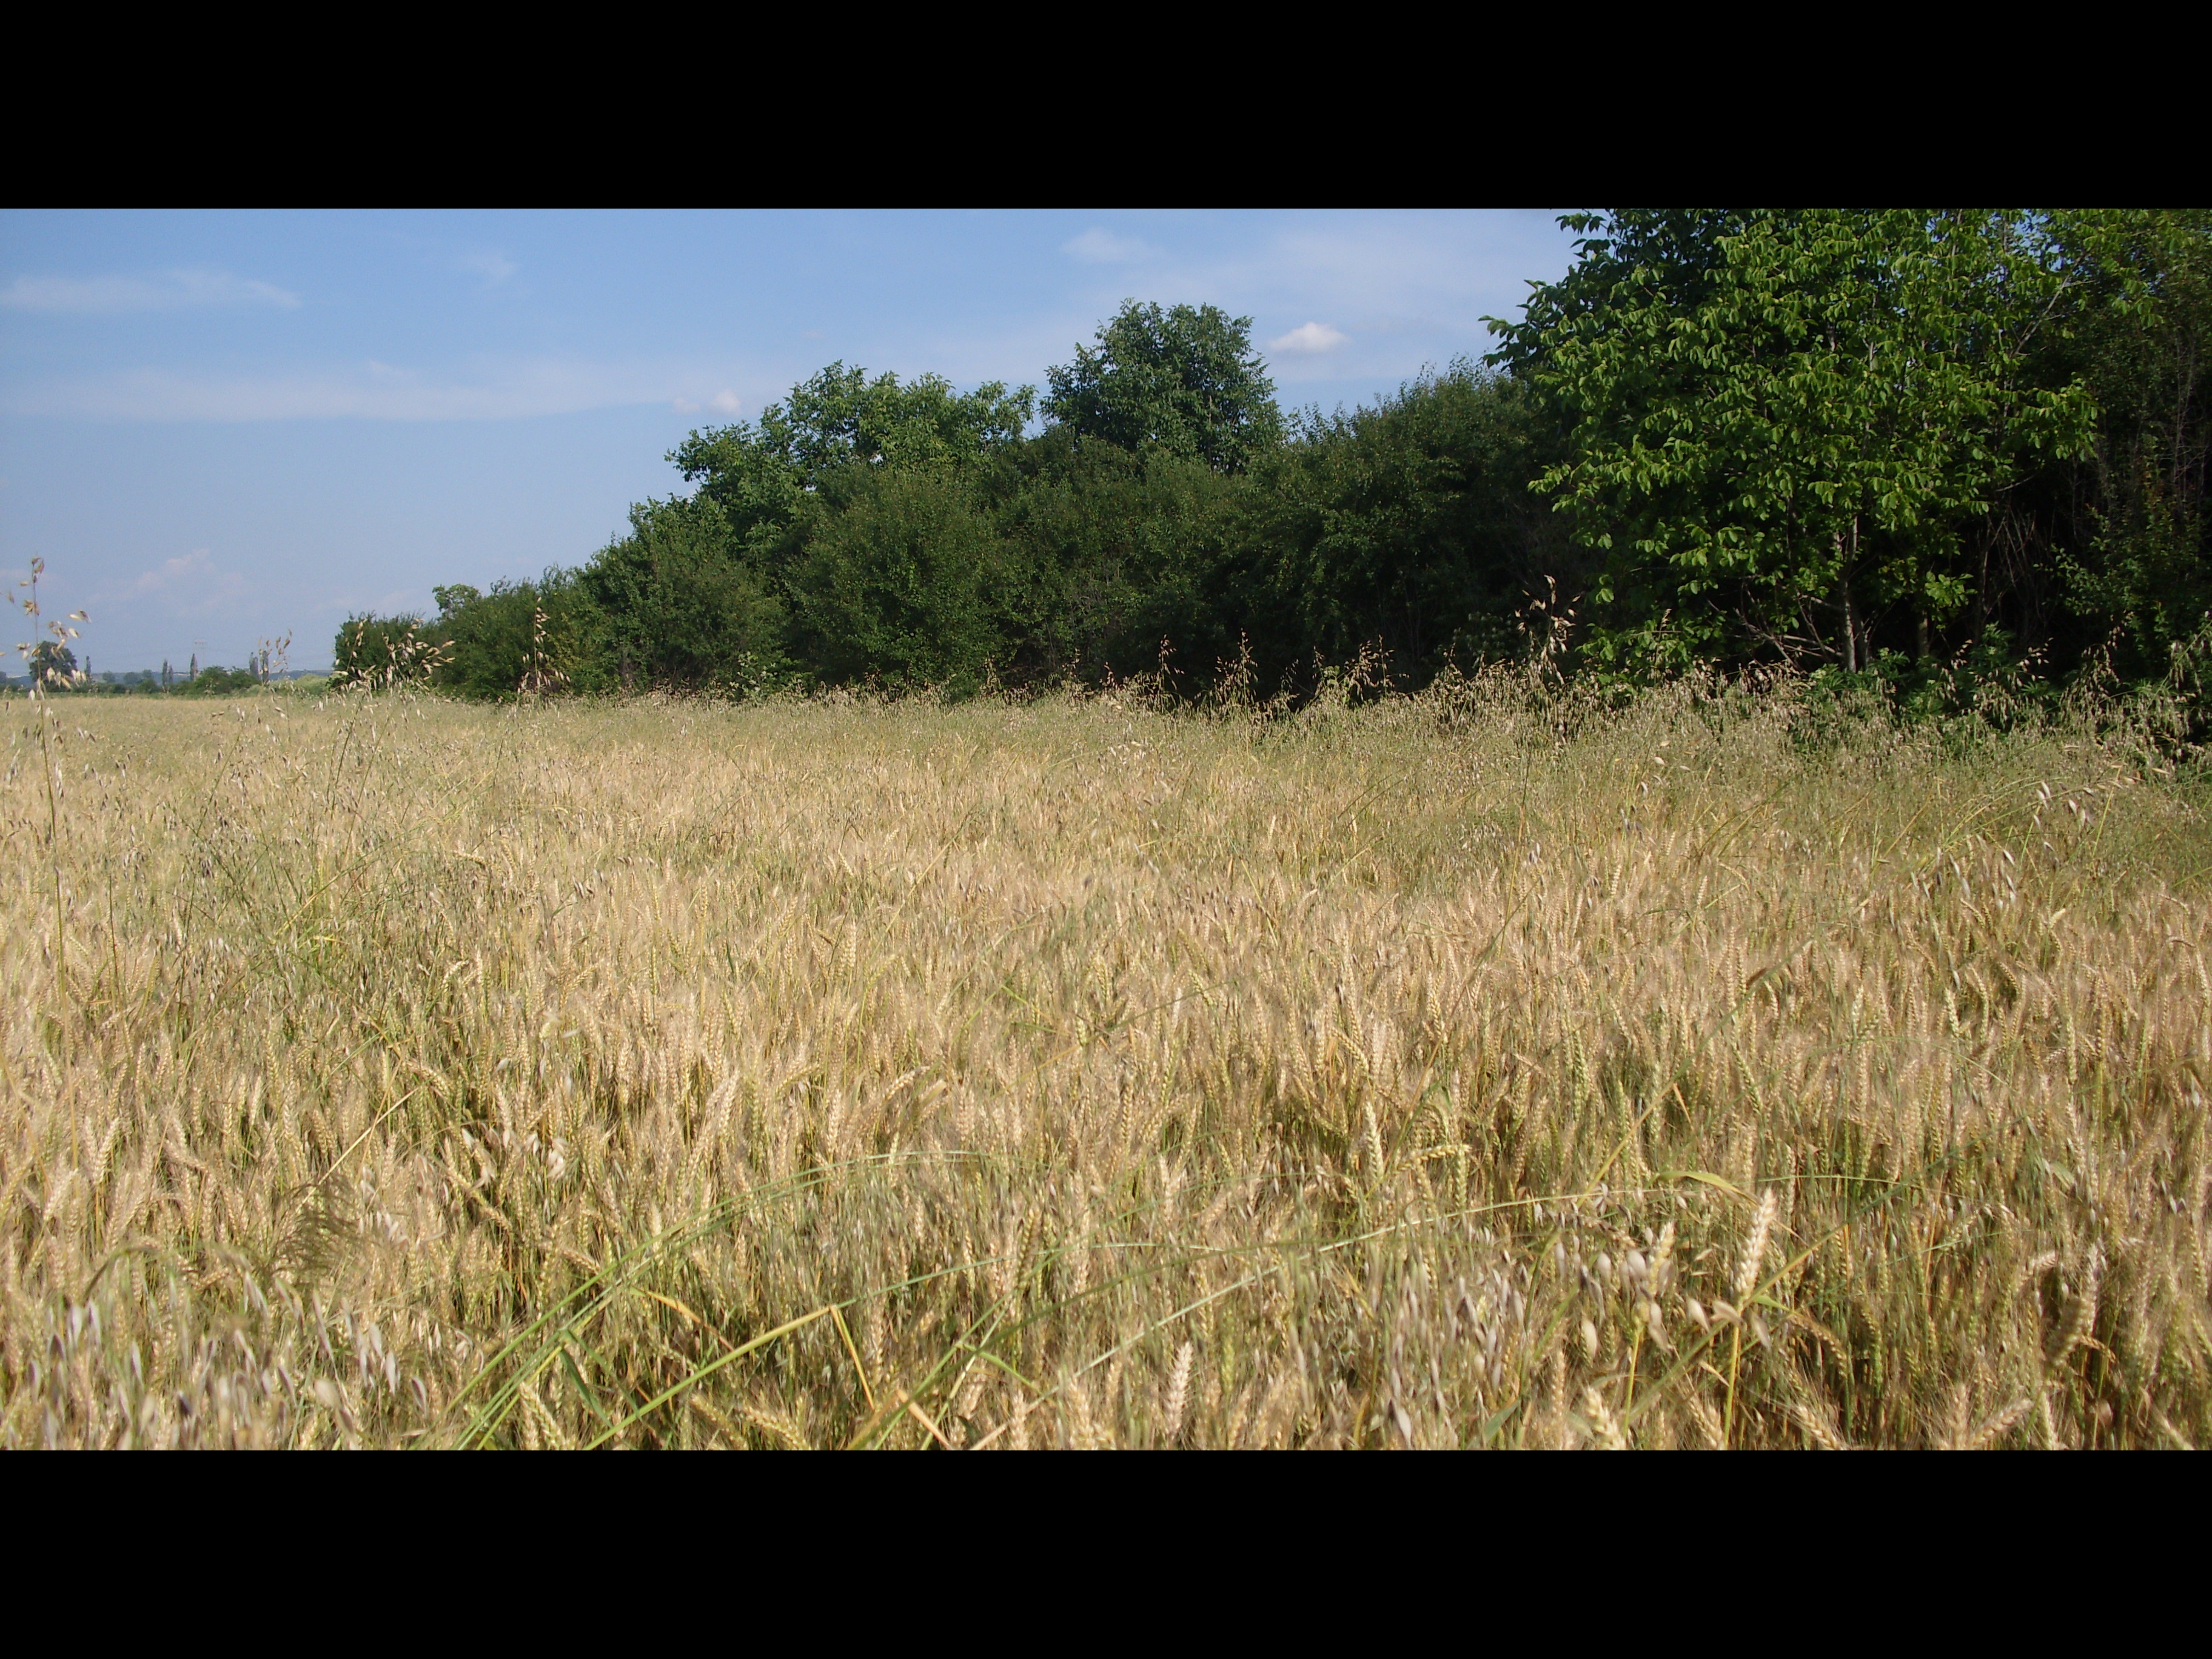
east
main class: Cropland
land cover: Common wheat
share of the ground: > 75 %
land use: Agriculture (excluding fallow land and kitchen gardens)
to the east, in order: Common wheat; Grass margins; Tracks; Grass margins; Sunflower
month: June
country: BG
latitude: 43.5292
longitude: 23.4193
